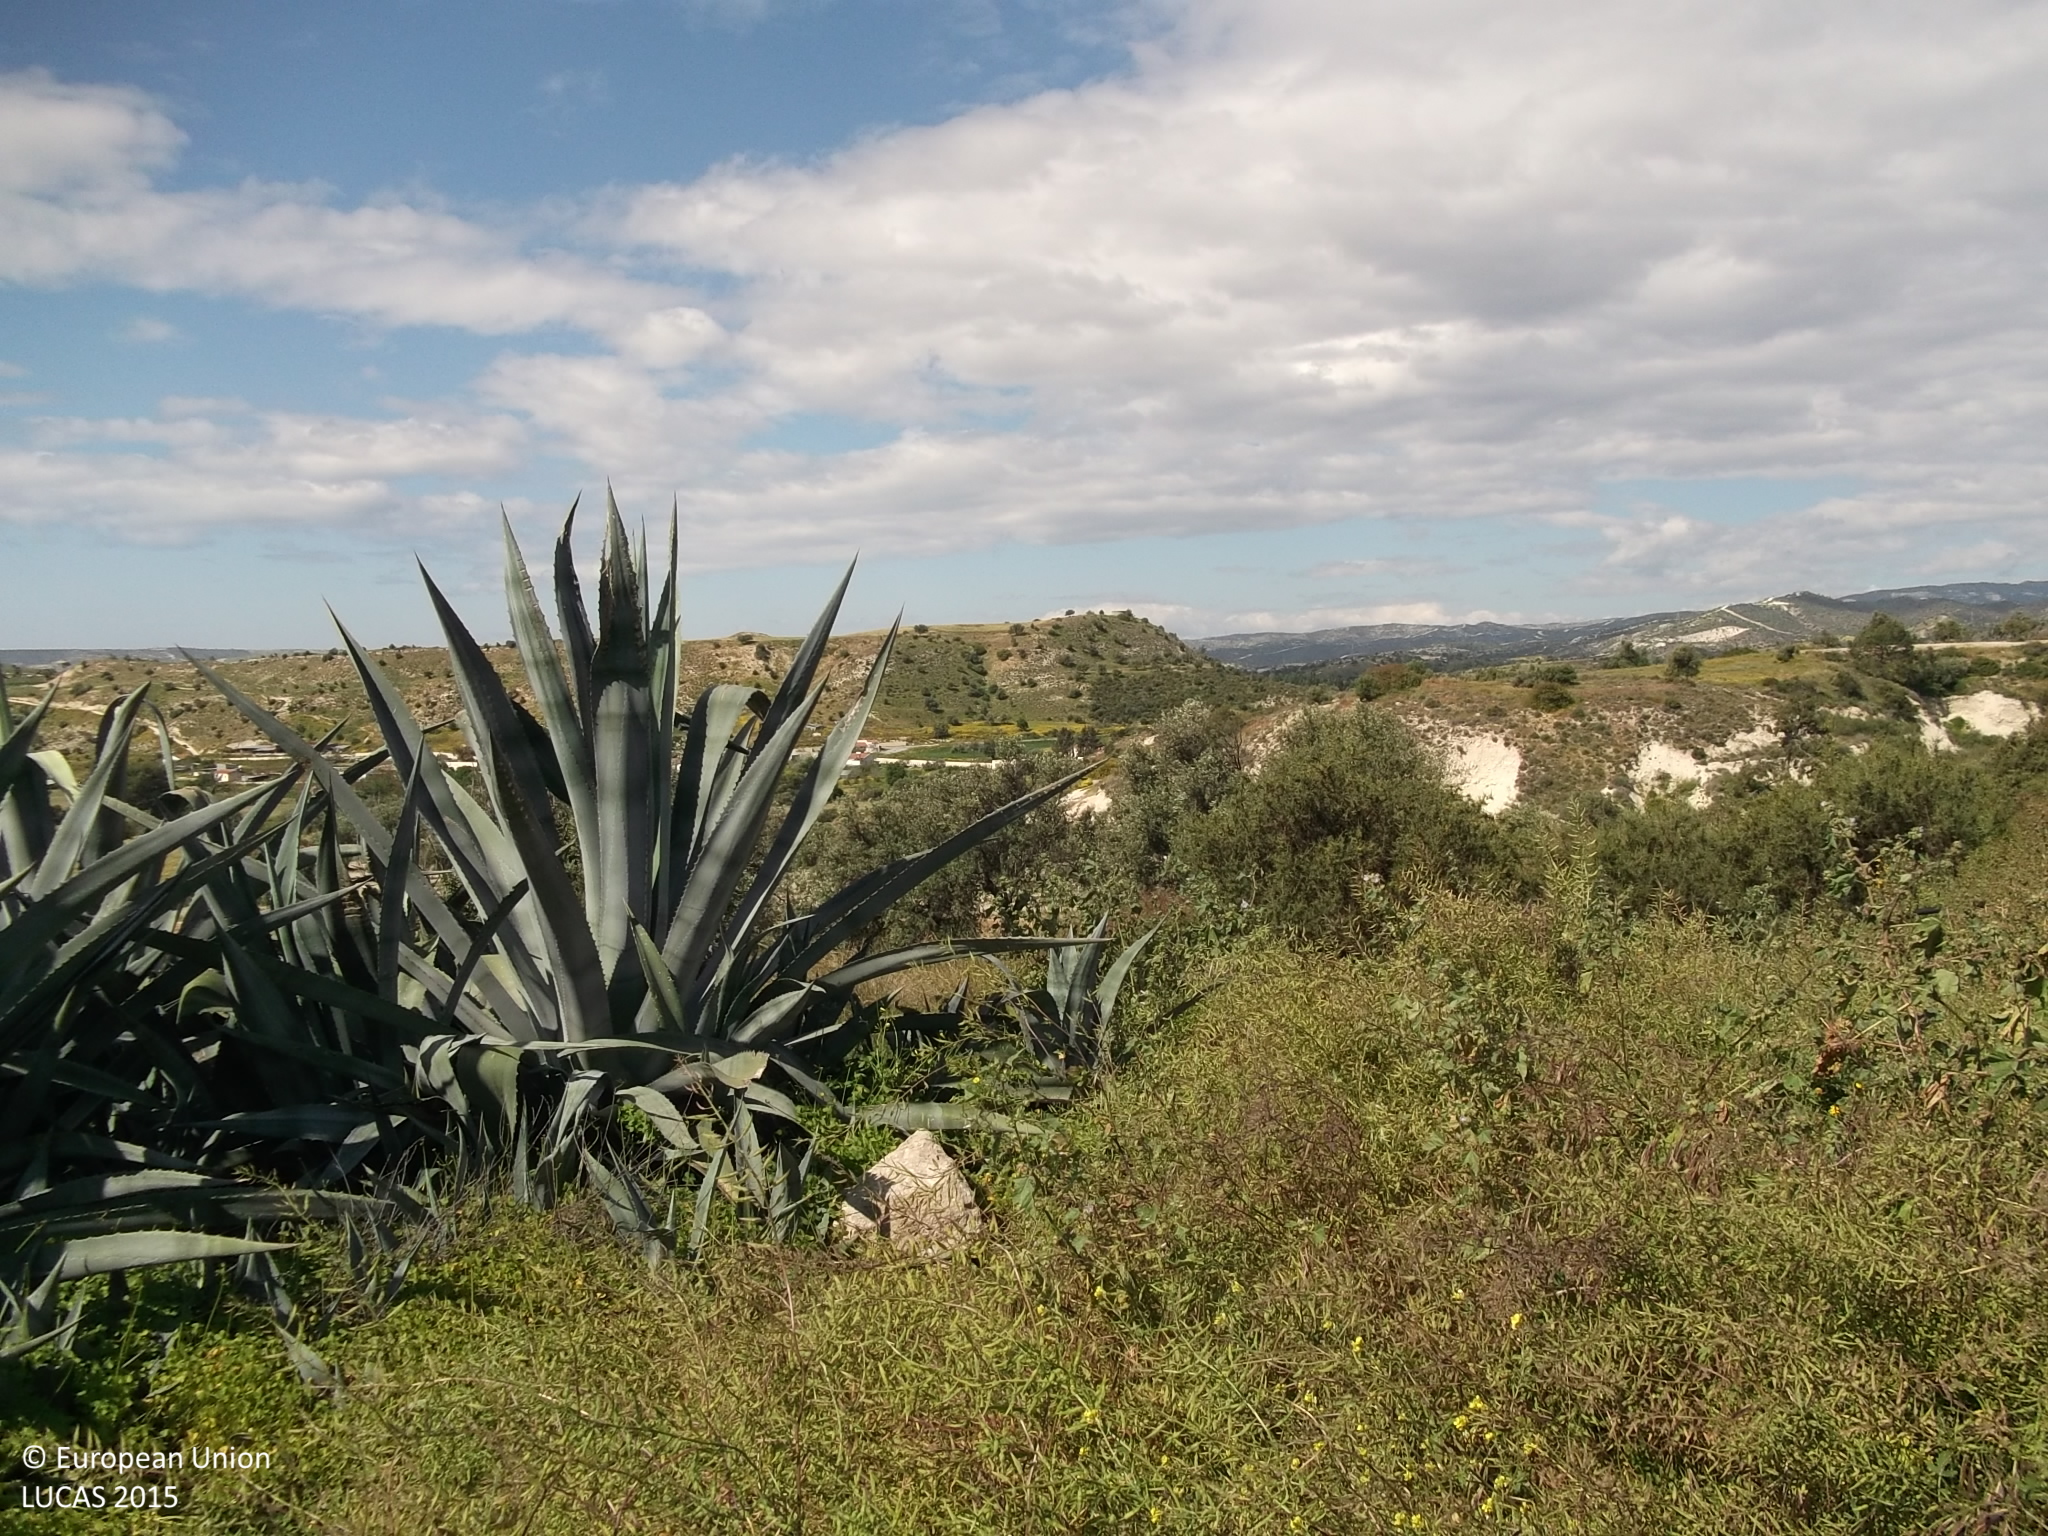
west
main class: Shrubland
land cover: Shrubland without tree cover
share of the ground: > 75 %
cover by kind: shrubs 70 %, herbaceous plants 30 %
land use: Semi-natural and natural areas not in use
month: April
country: CY
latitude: 34.8470
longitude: 33.4484
